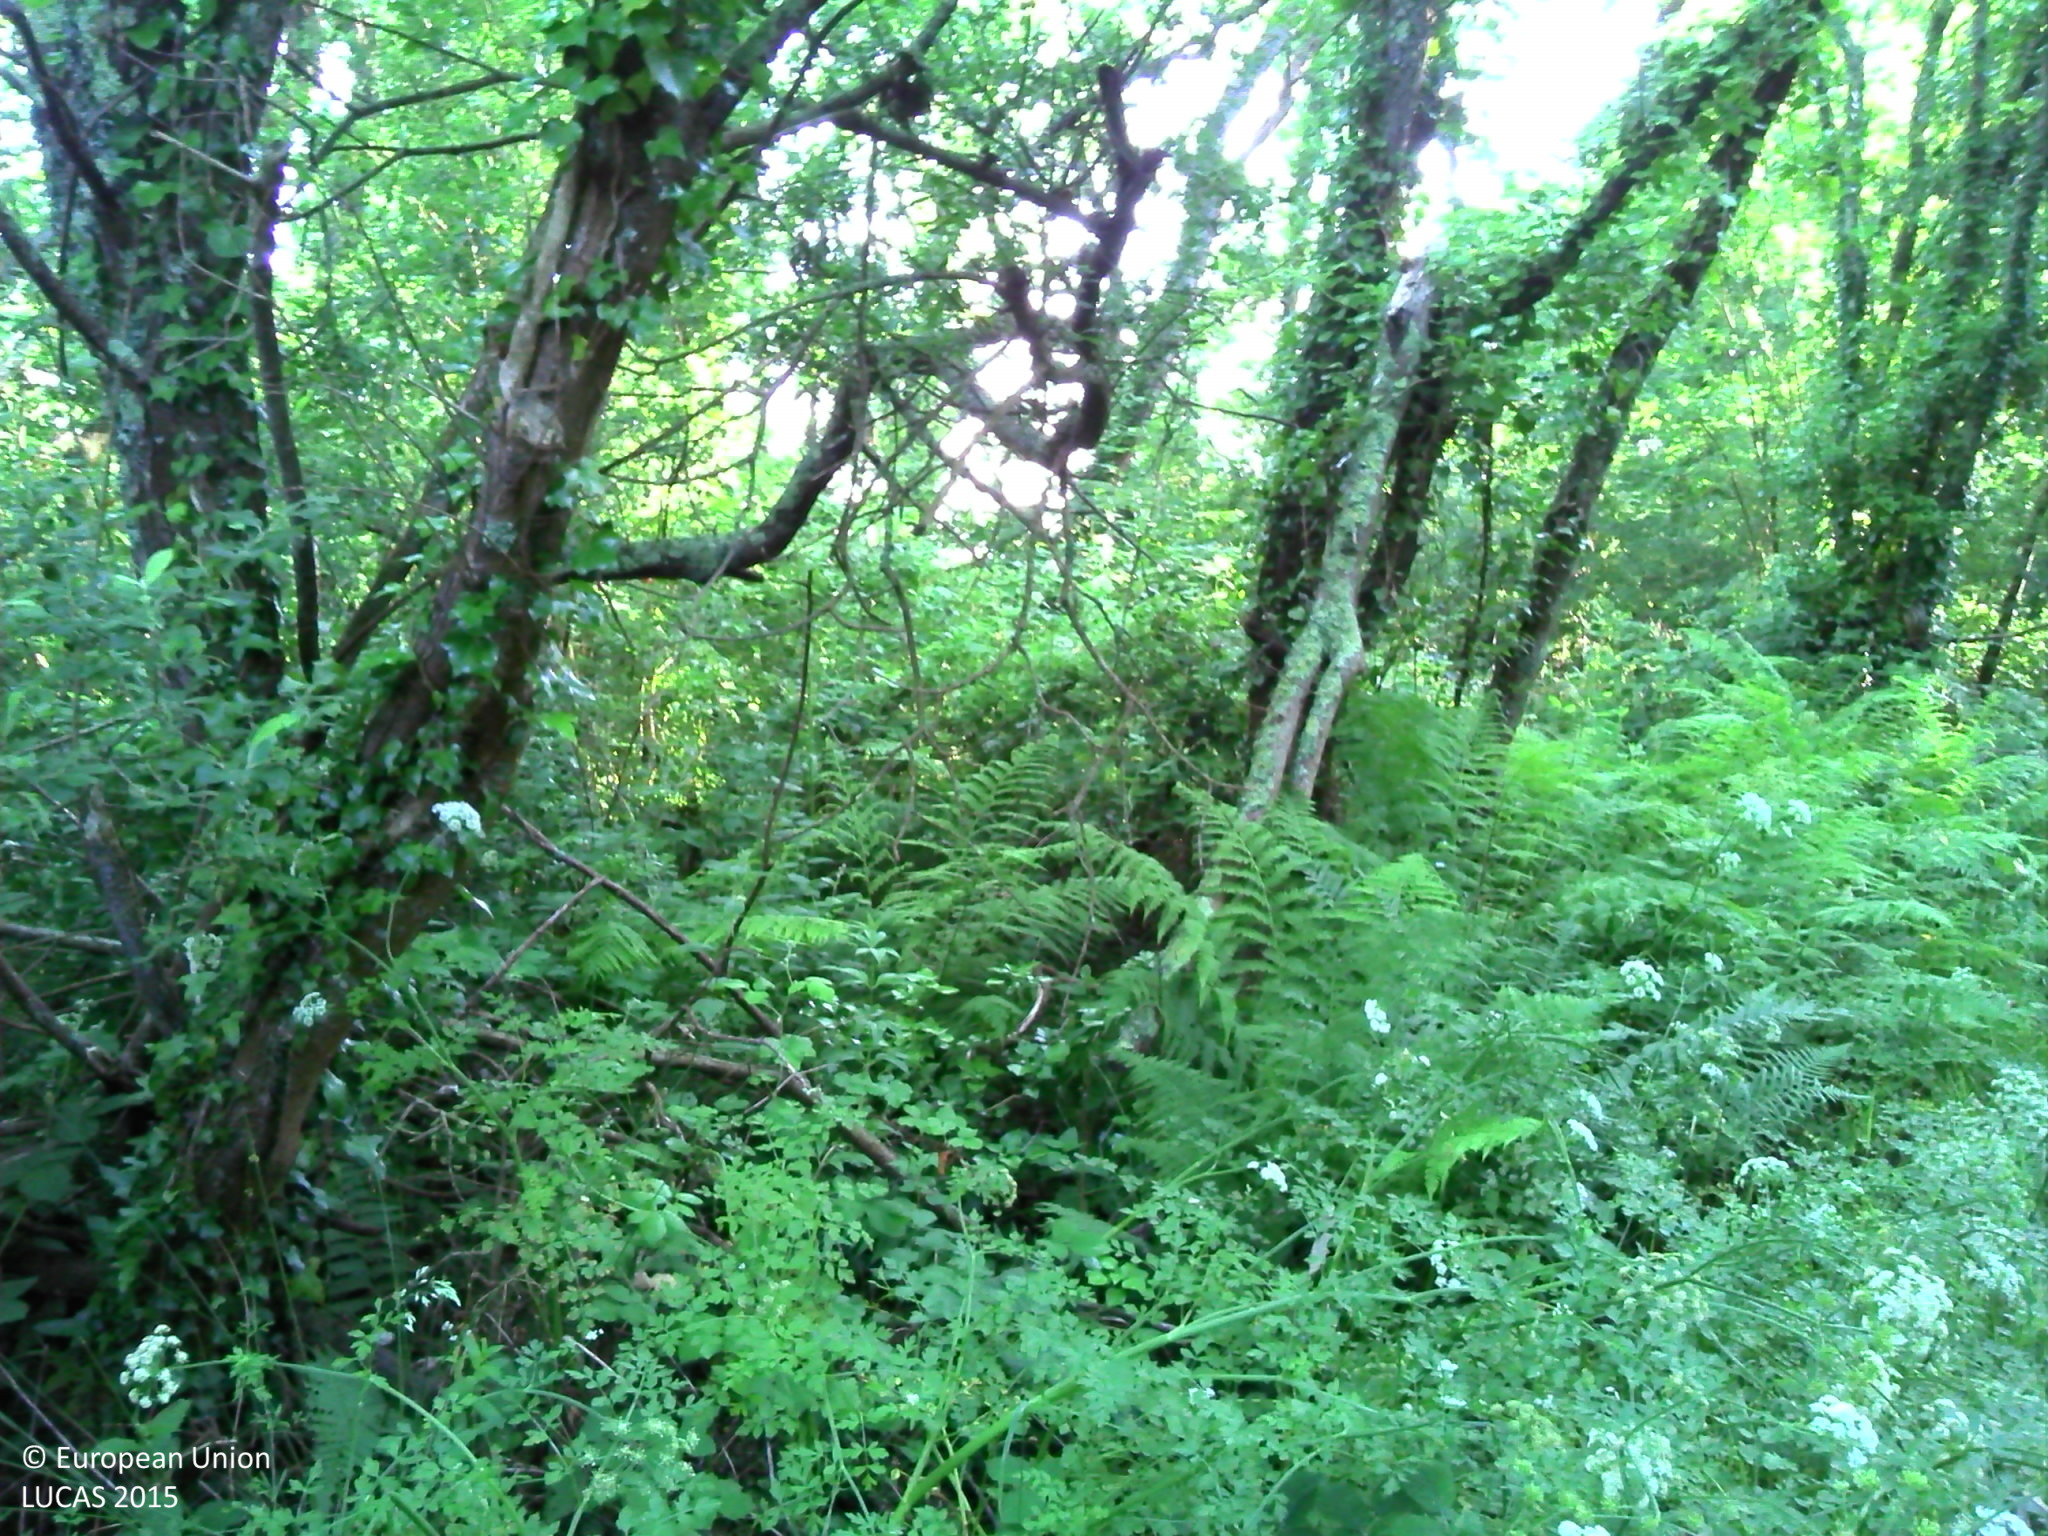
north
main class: Woodland
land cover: Broadleaved woodland
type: acidophilous oak and oak-birch forest
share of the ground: > 75 %
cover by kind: broadleaved forest trees 85 %, herbaceous plants 10 %, shrubs 5 %
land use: Forestry
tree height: > 5 m
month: June
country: FR
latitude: 49.1818
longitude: -1.5042
